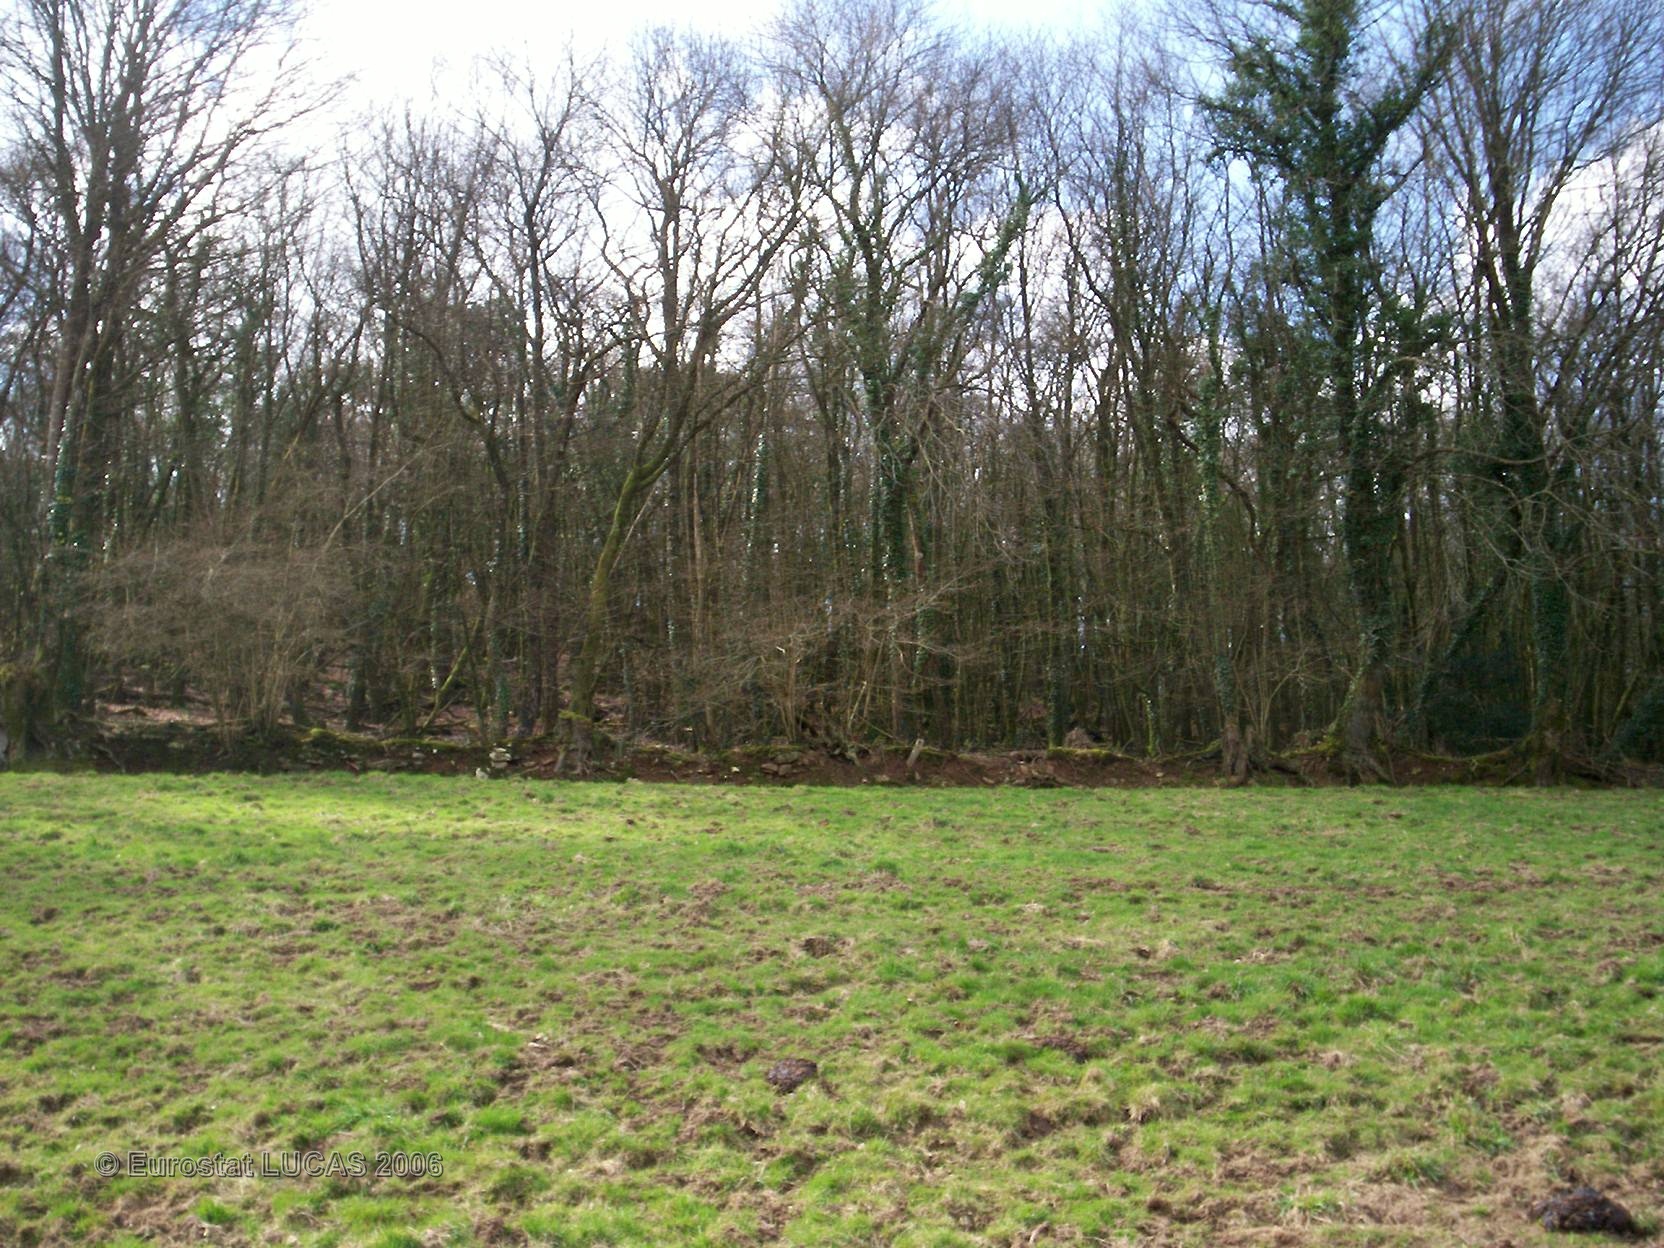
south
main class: Grassland
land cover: Grassland without tree/shrub cover
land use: Agriculture (excluding fallow land and kitchen gardens)
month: April
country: FR
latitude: 48.0590
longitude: -3.5357
